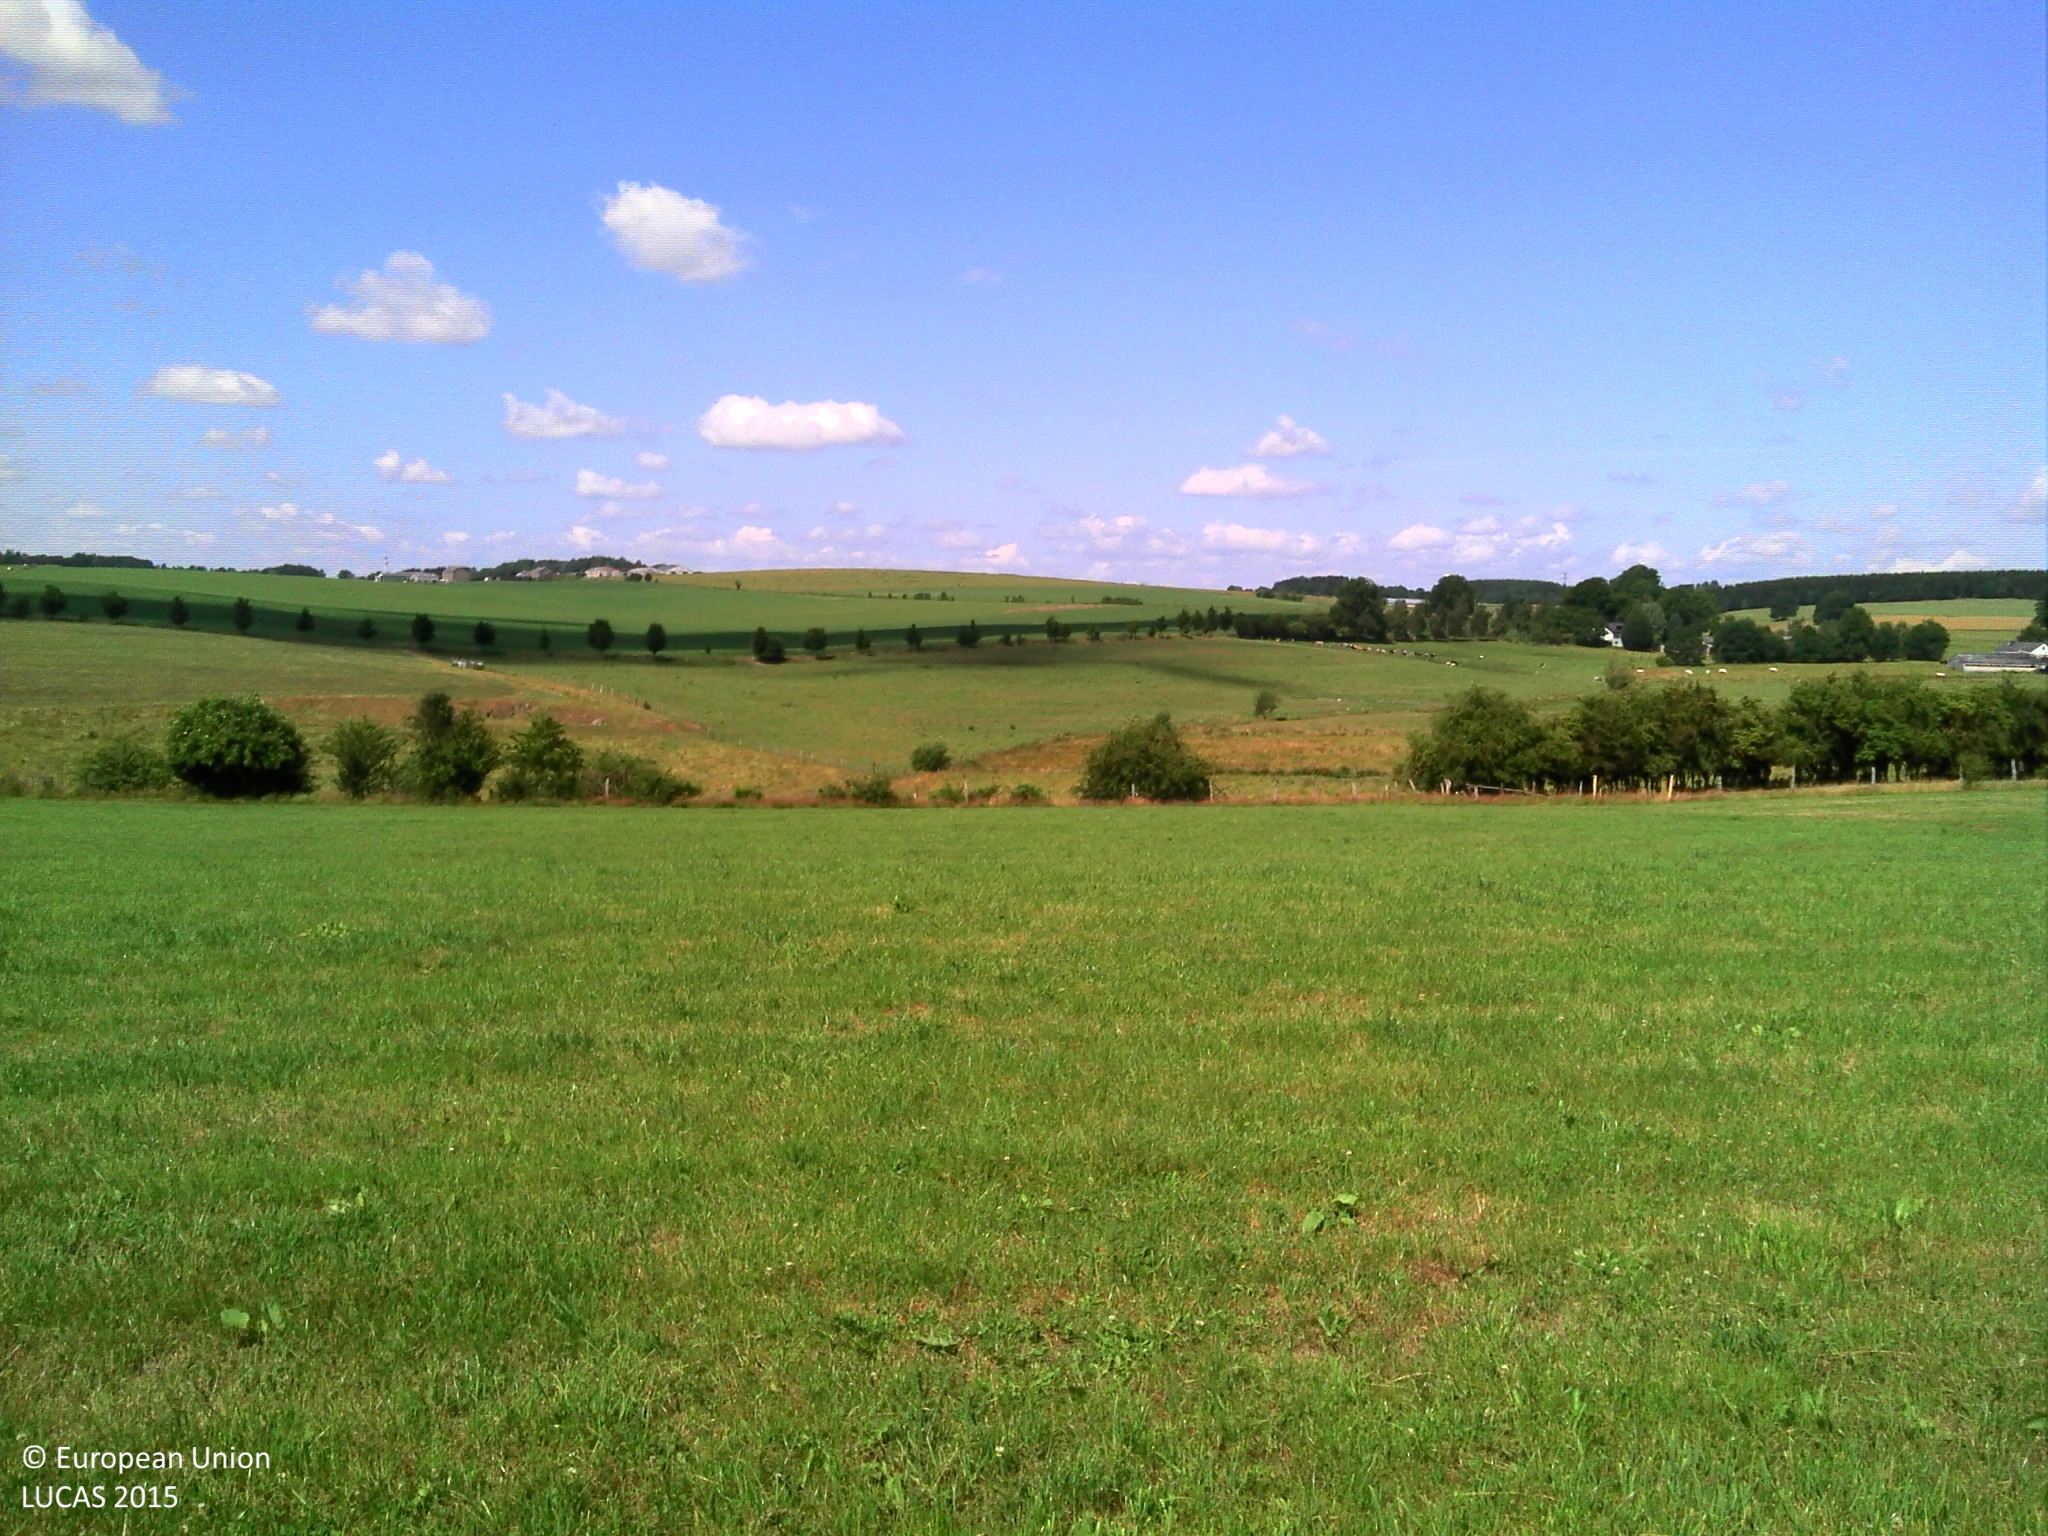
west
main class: Grassland
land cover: Grassland without tree/shrub cover
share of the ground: > 75 %
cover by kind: herbaceous plants 100 %
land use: Agriculture (excluding fallow land and kitchen gardens)
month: July
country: BE
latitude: 50.0158
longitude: 5.7702
